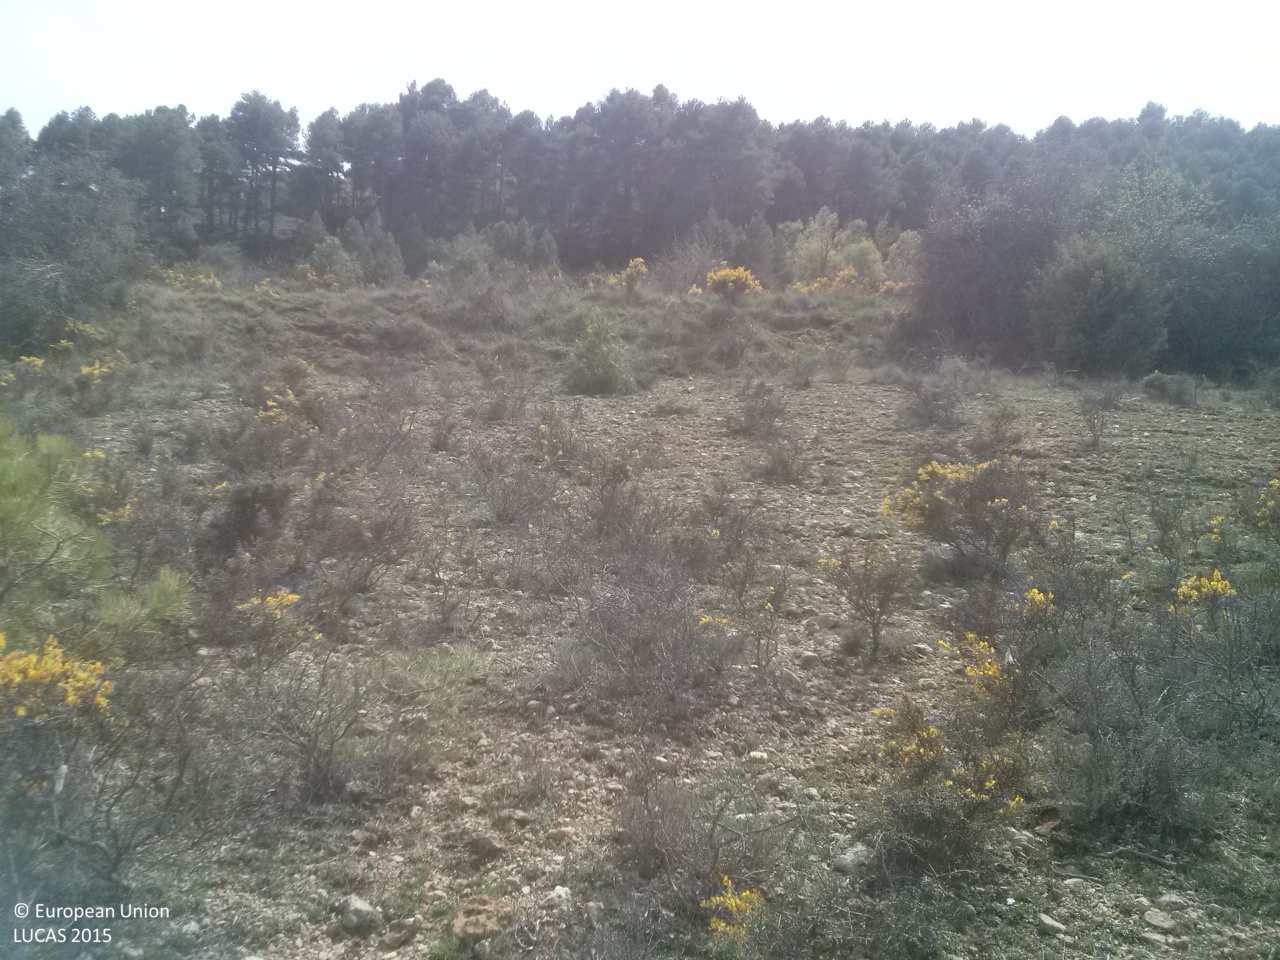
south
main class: Shrubland
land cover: Shrubland without tree cover
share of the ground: > 75 %
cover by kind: shrubs 80 %, herbaceous plants 20 %
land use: Agriculture (excluding fallow land and kitchen gardens)
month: April
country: ES
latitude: 40.0467
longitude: -1.7924
